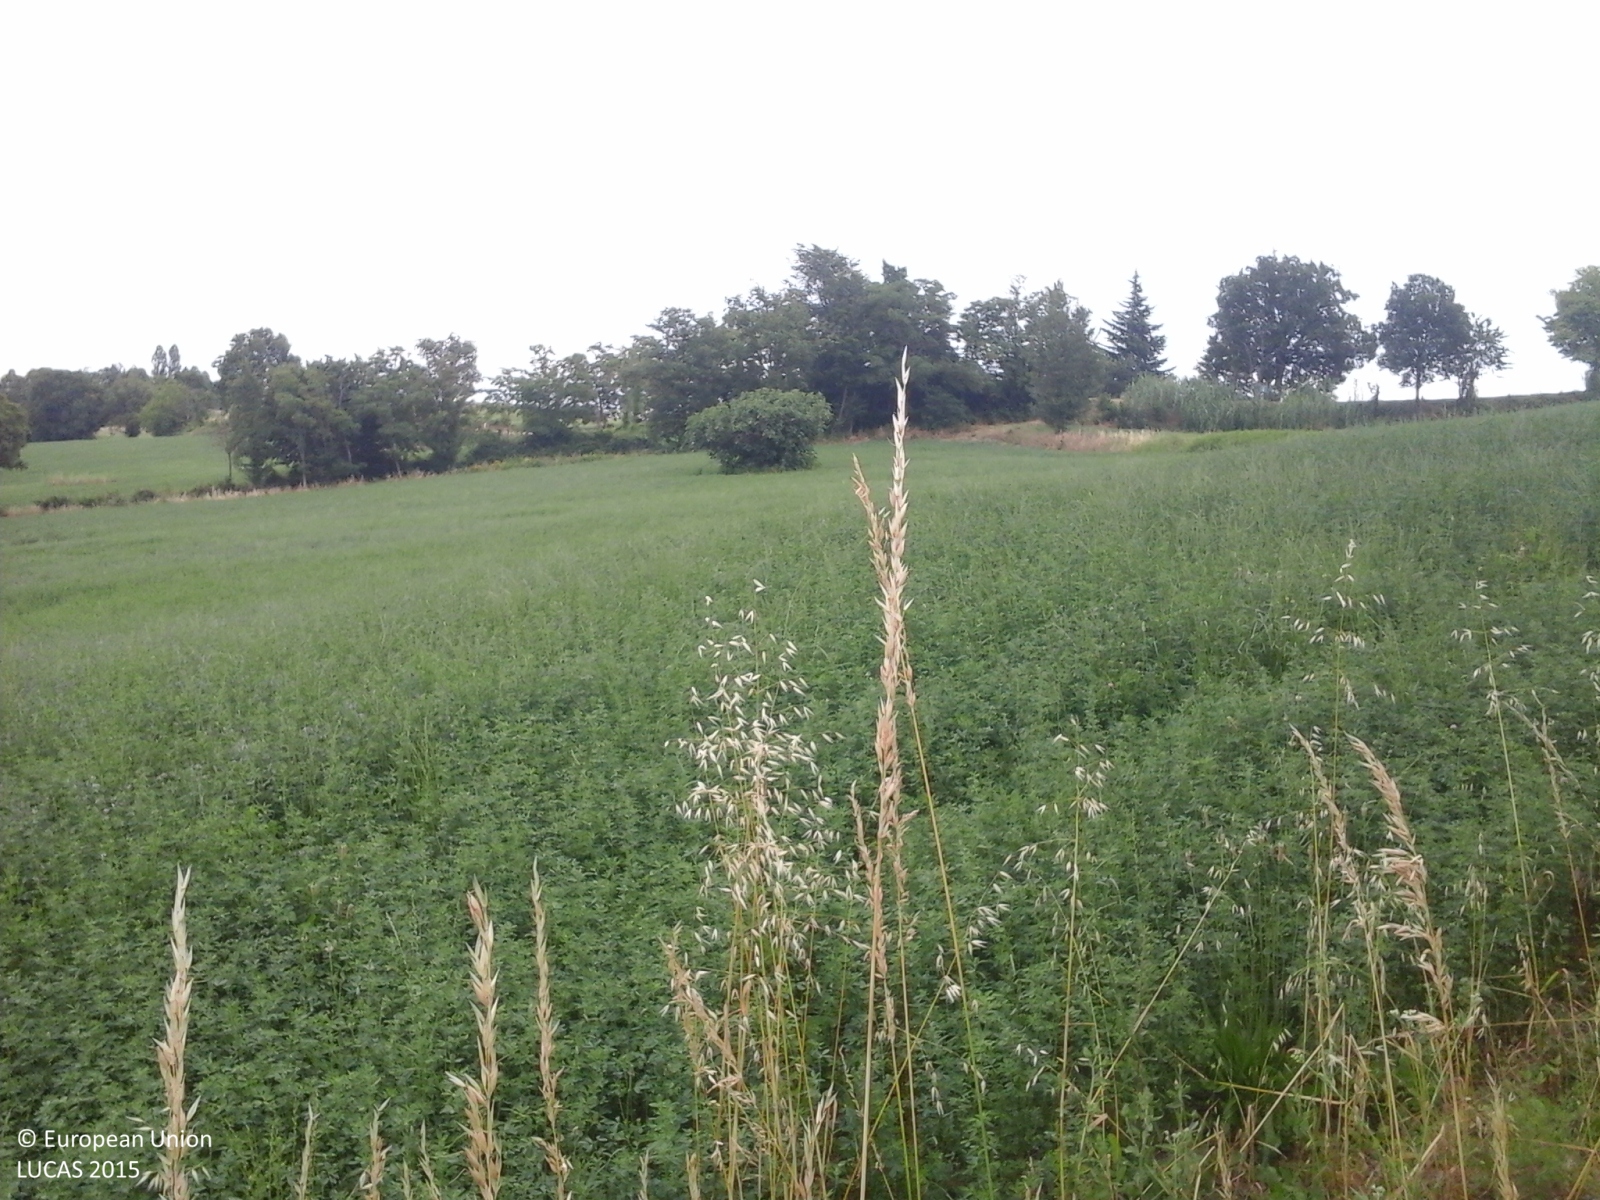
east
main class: Woodland
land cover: Broadleaved woodland
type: thermophilous deciduous forest
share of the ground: > 75 %
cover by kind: broadleaved forest trees 90 %, shrubs 10 %
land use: Forestry
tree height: > 5 m
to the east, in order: Broadleaved woodland; Lucerne; Single bushes/trees; Lucerne; Broadleaved woodland; Artificial constructions in urban areas; Grassland without tree/shrub cover
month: June
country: IT
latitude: 44.6026
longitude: 10.2891
